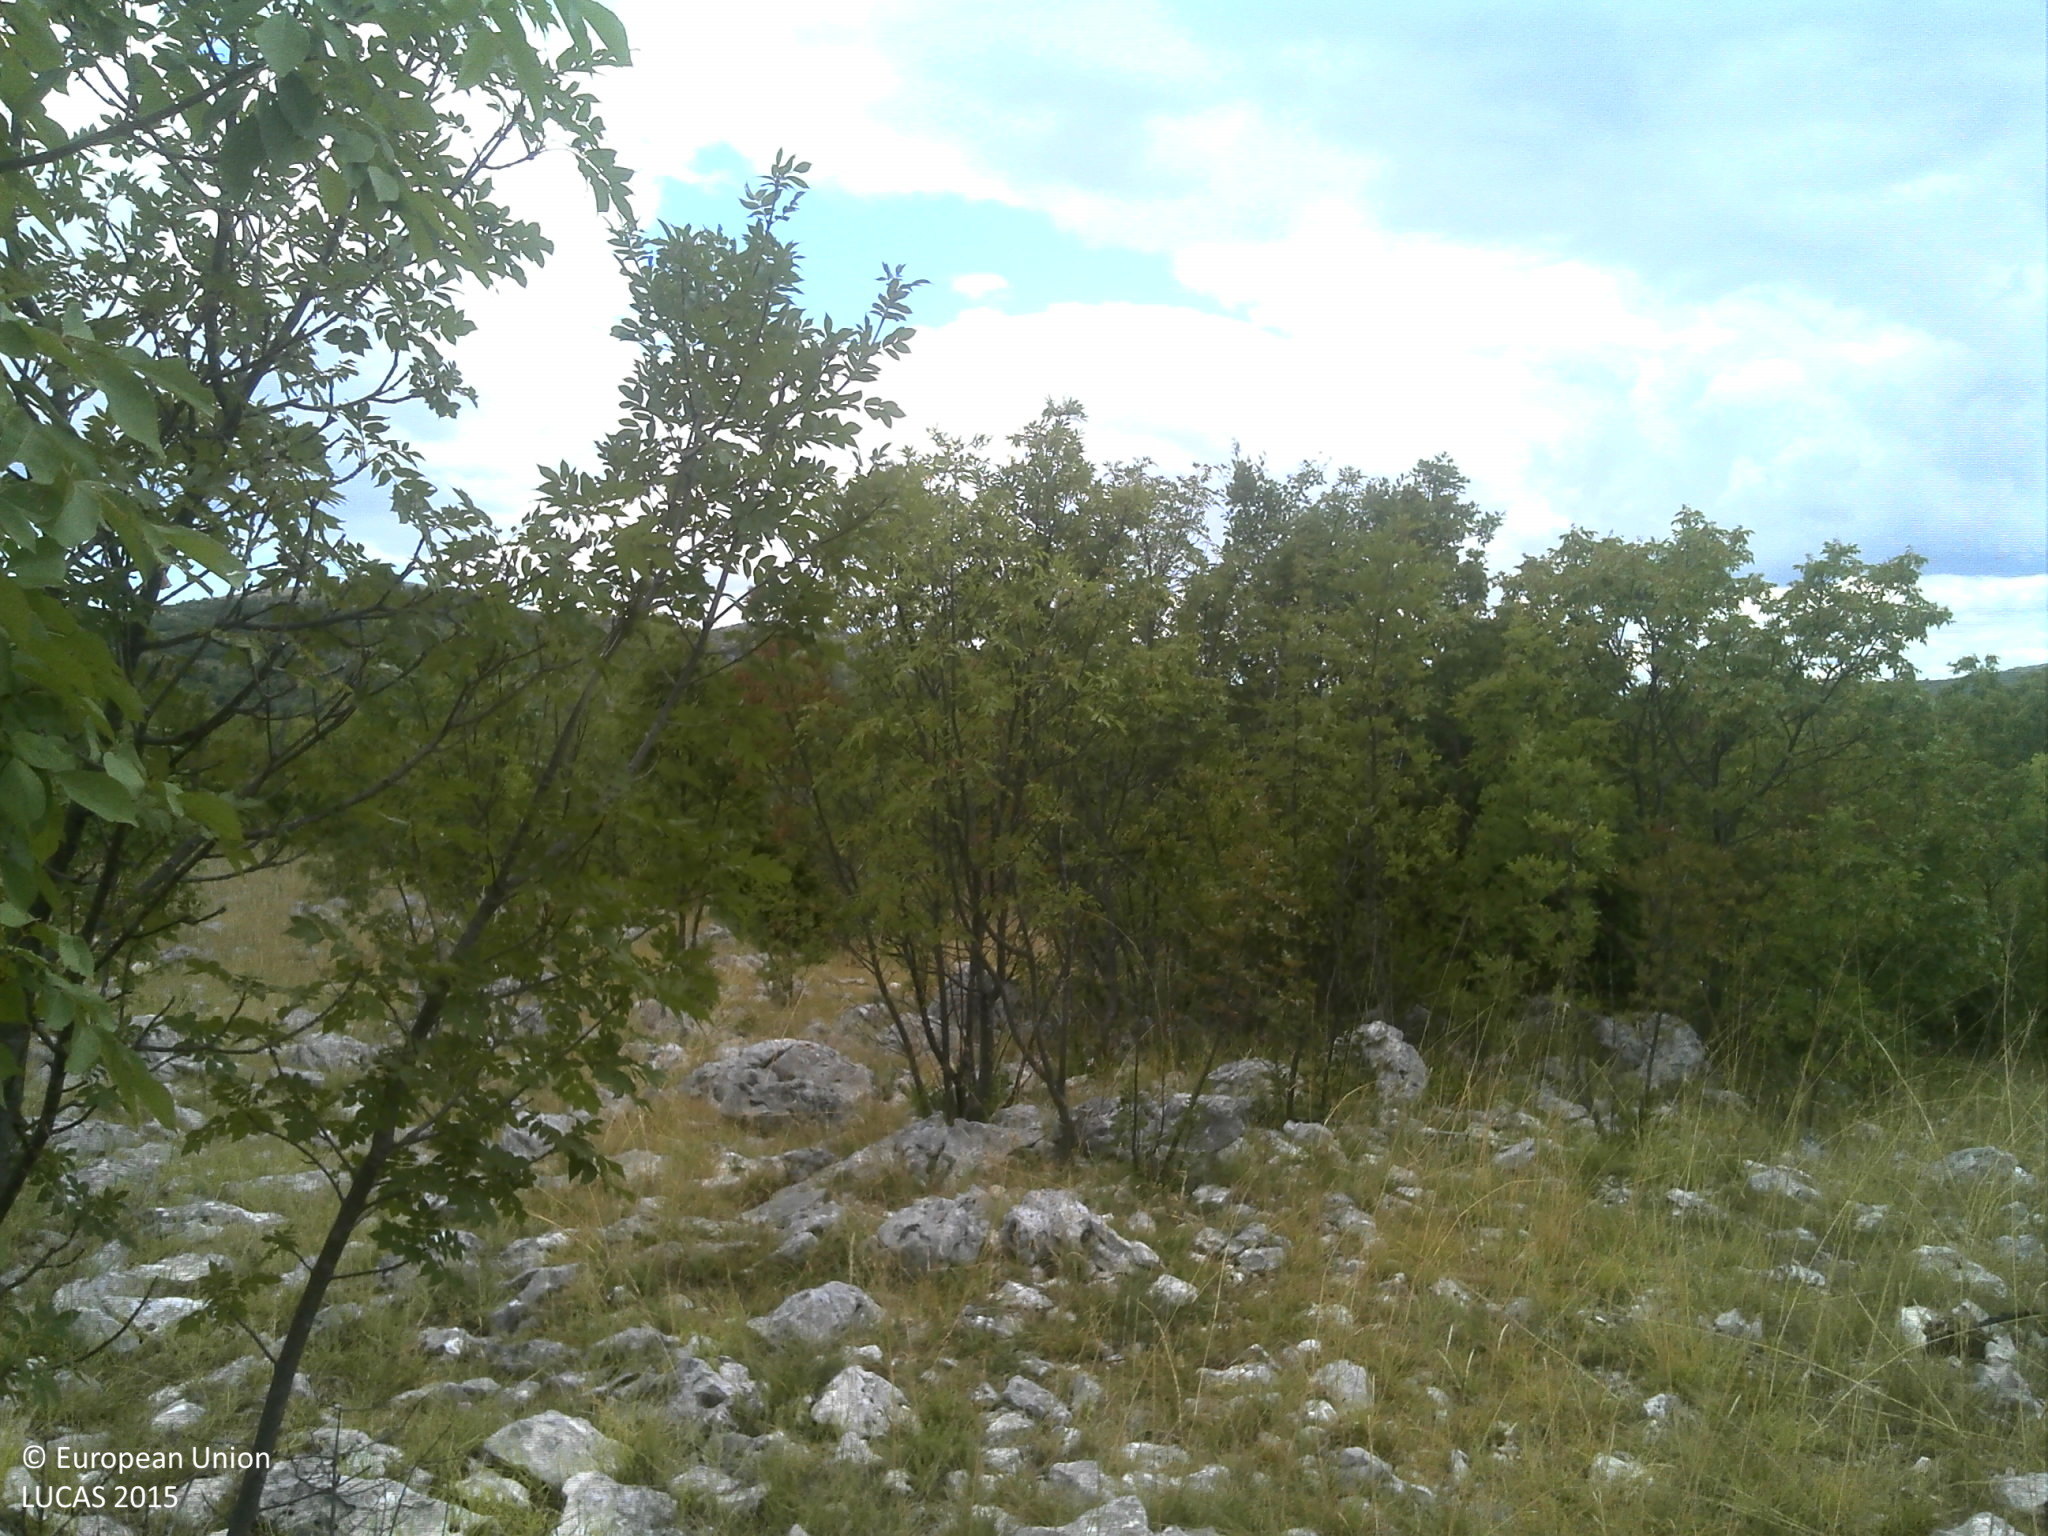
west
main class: Shrubland
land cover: Shrubland with sparse tree cover
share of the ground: 25 - 50 %
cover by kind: shrubs 35 %, herbaceous plants 30 %, unconsolidated bare surface 20 %, consolidated bare surface 10 %, broadleaved forest trees 5 %
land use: Semi-natural and natural areas not in use
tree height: < 5 m
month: August
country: HR
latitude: 43.6073
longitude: 16.4461
